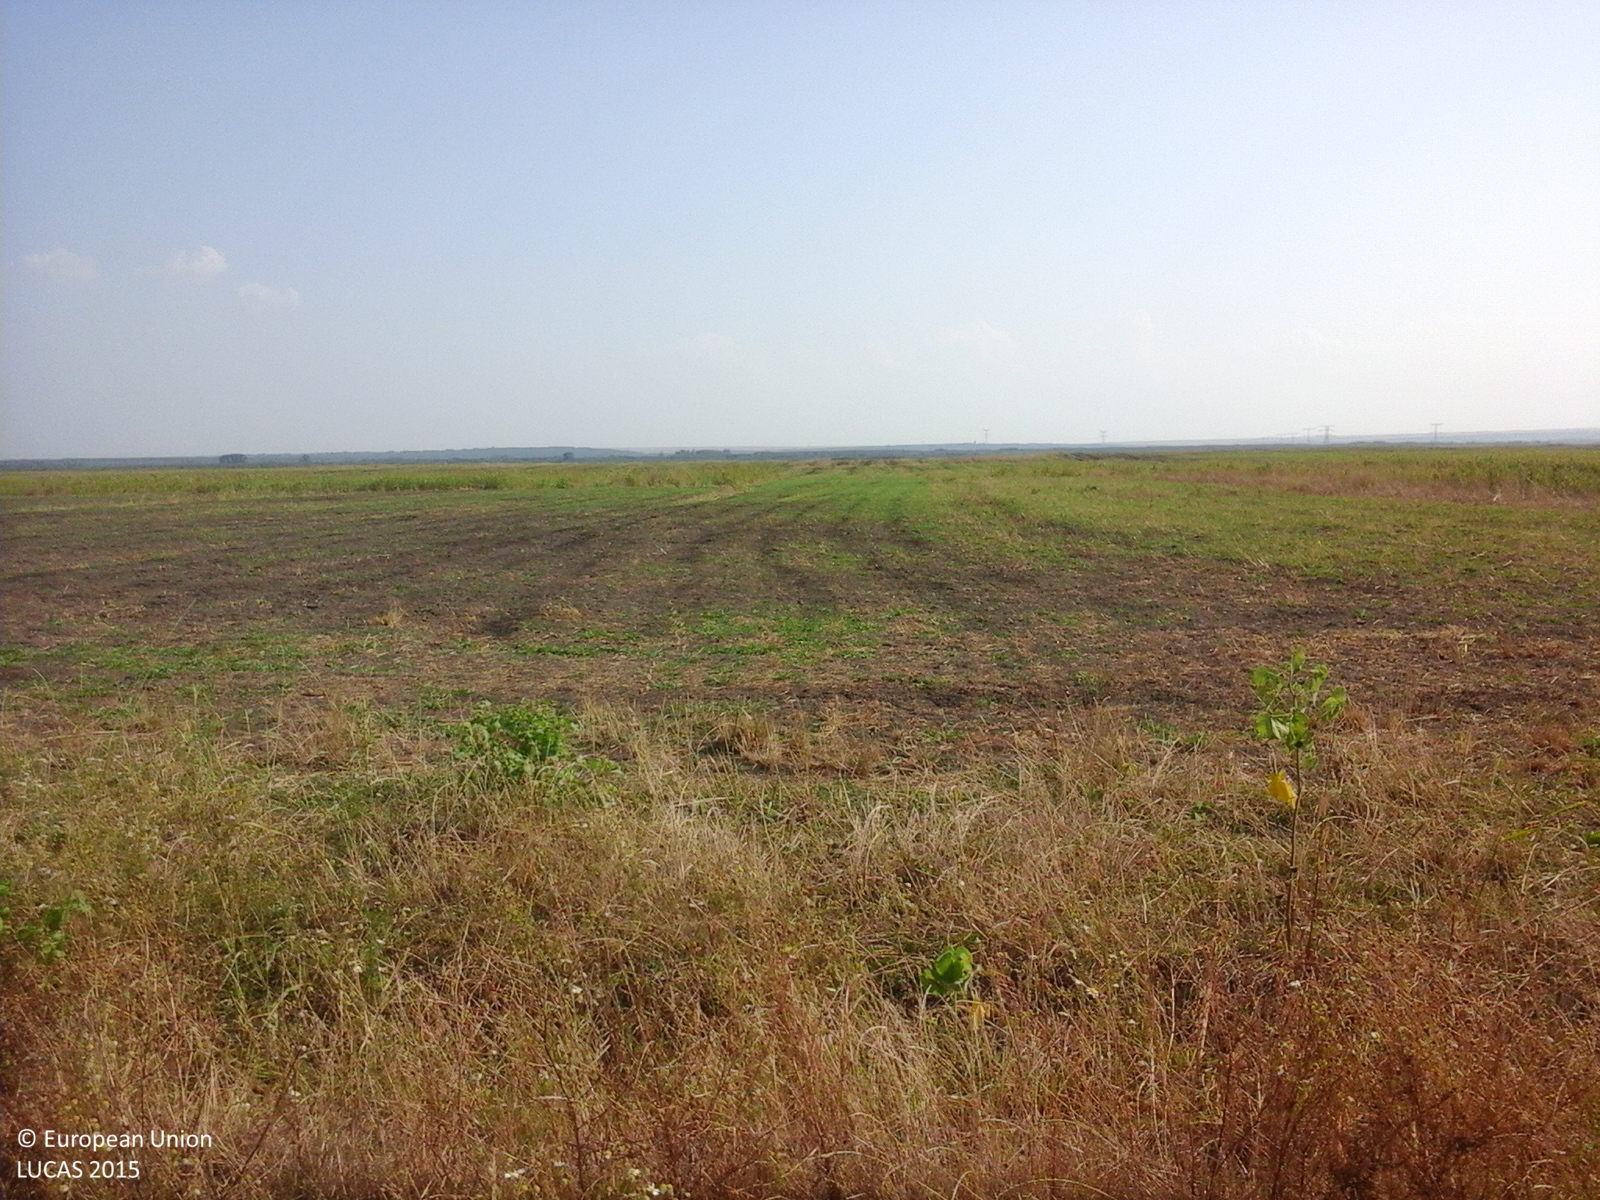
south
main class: Cropland
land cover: Sunflower
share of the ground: > 75 %
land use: Agriculture (excluding fallow land and kitchen gardens)
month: August
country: RO
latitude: 43.8607
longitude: 23.6745
